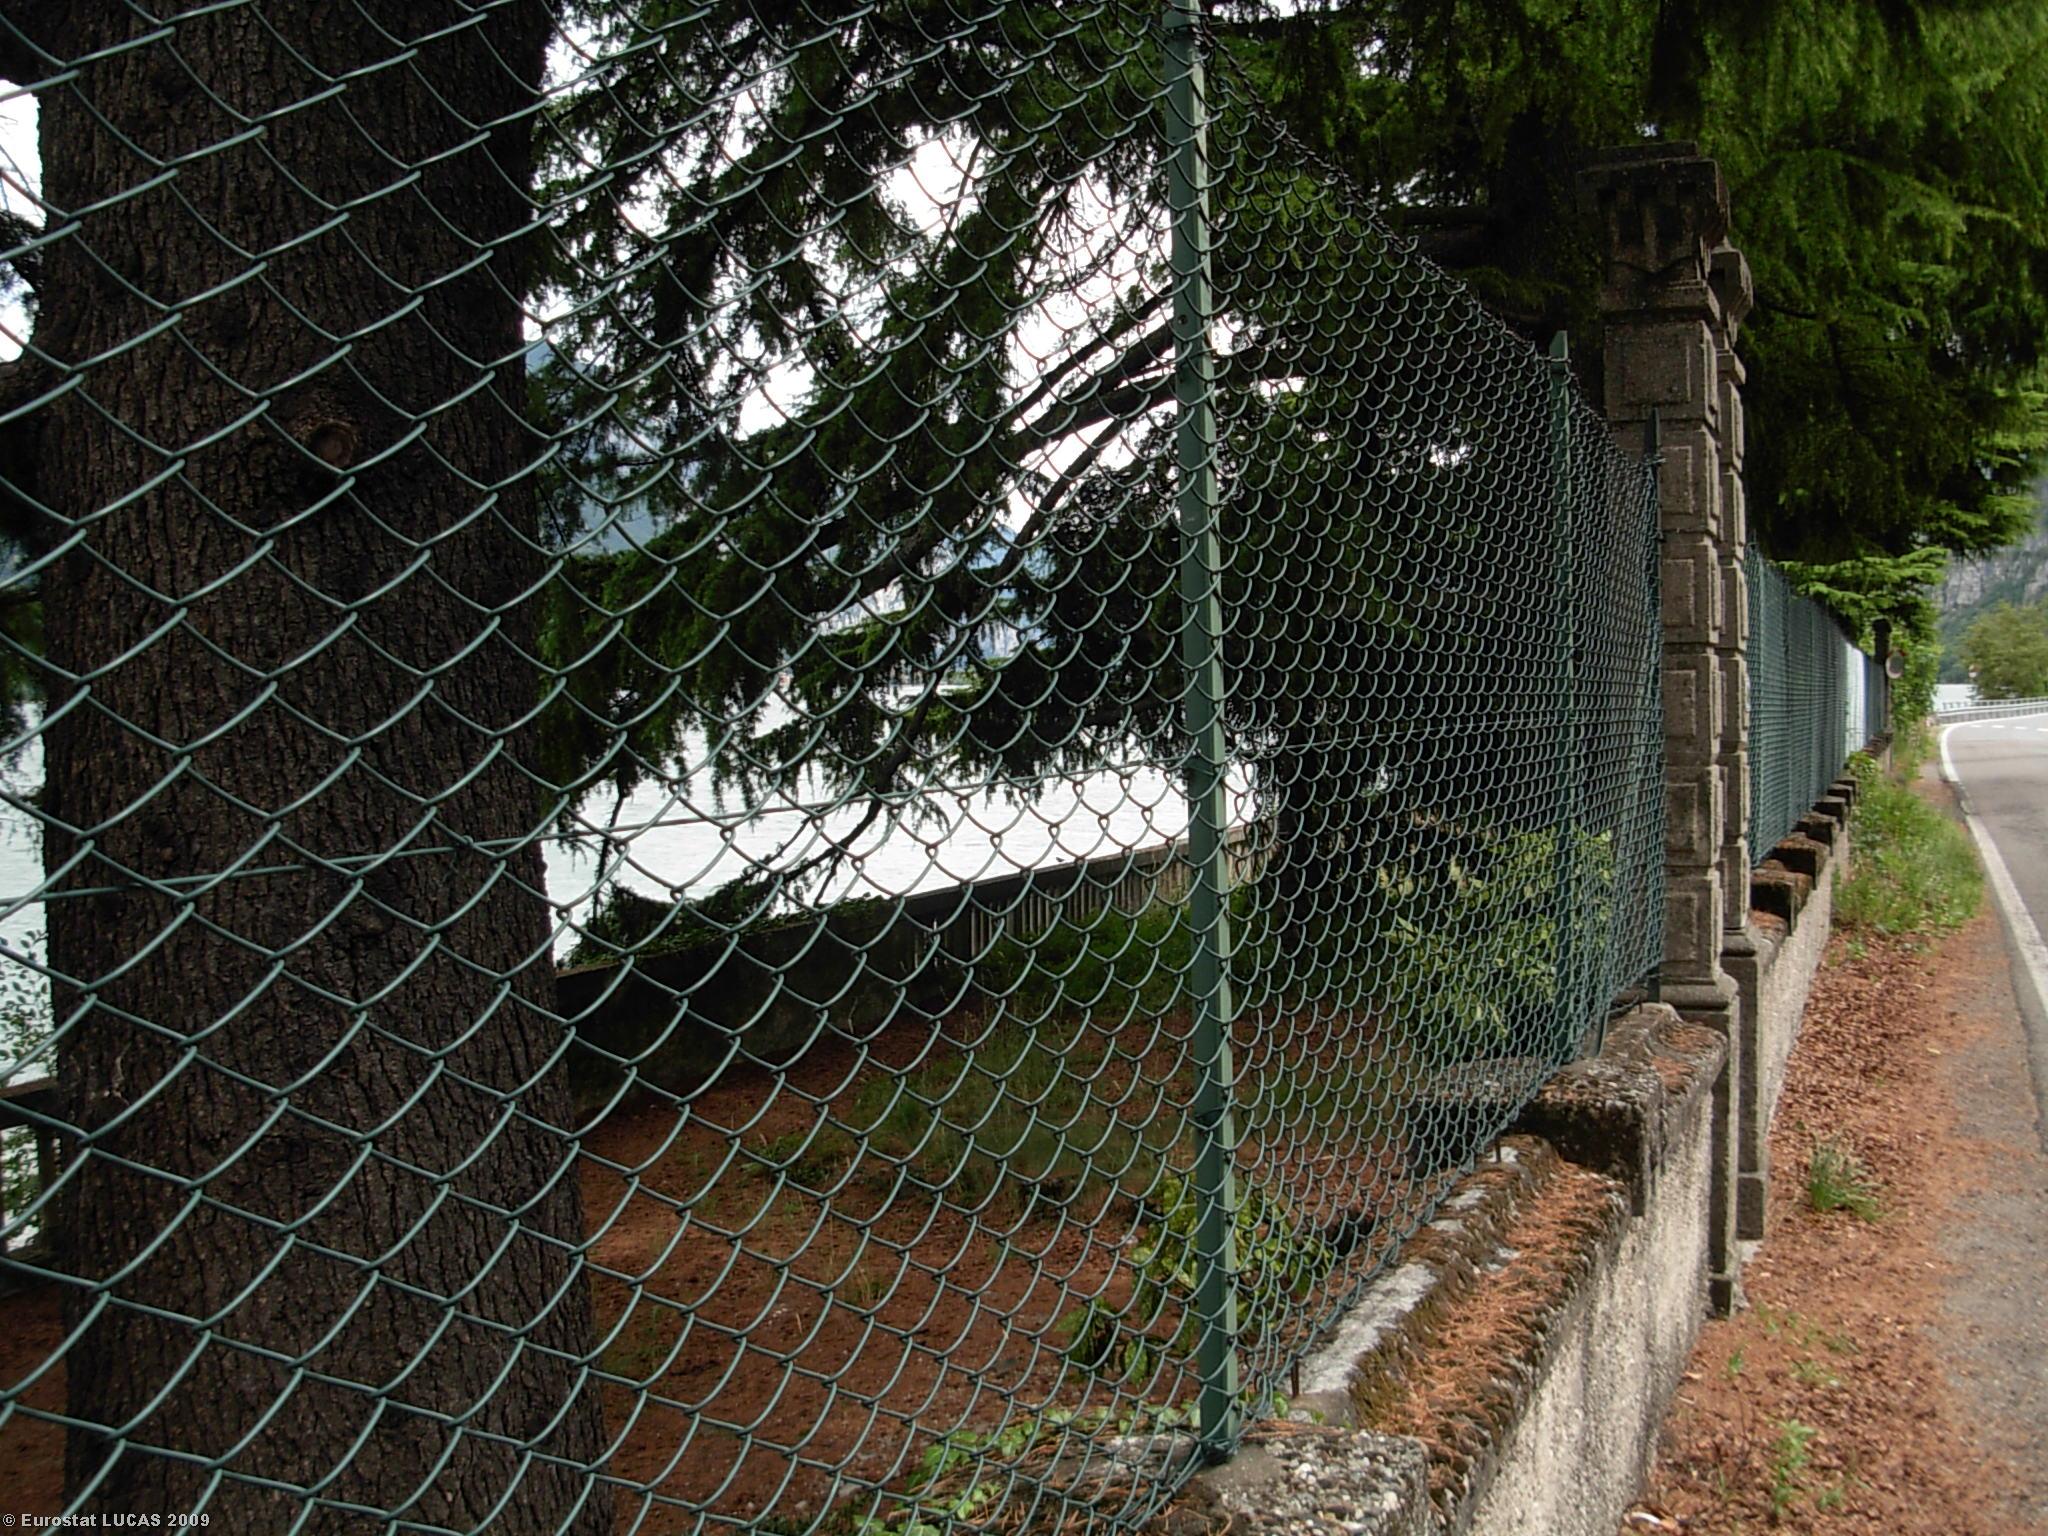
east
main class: Woodland
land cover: Coniferous woodland
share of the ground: > 75 %
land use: Holiday camps
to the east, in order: Coniferous woodland; Grassland with sparse tree/shrub cover; Fences; Bare land; Inland water bodies
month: June
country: IT
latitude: 45.9165
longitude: 9.2920
